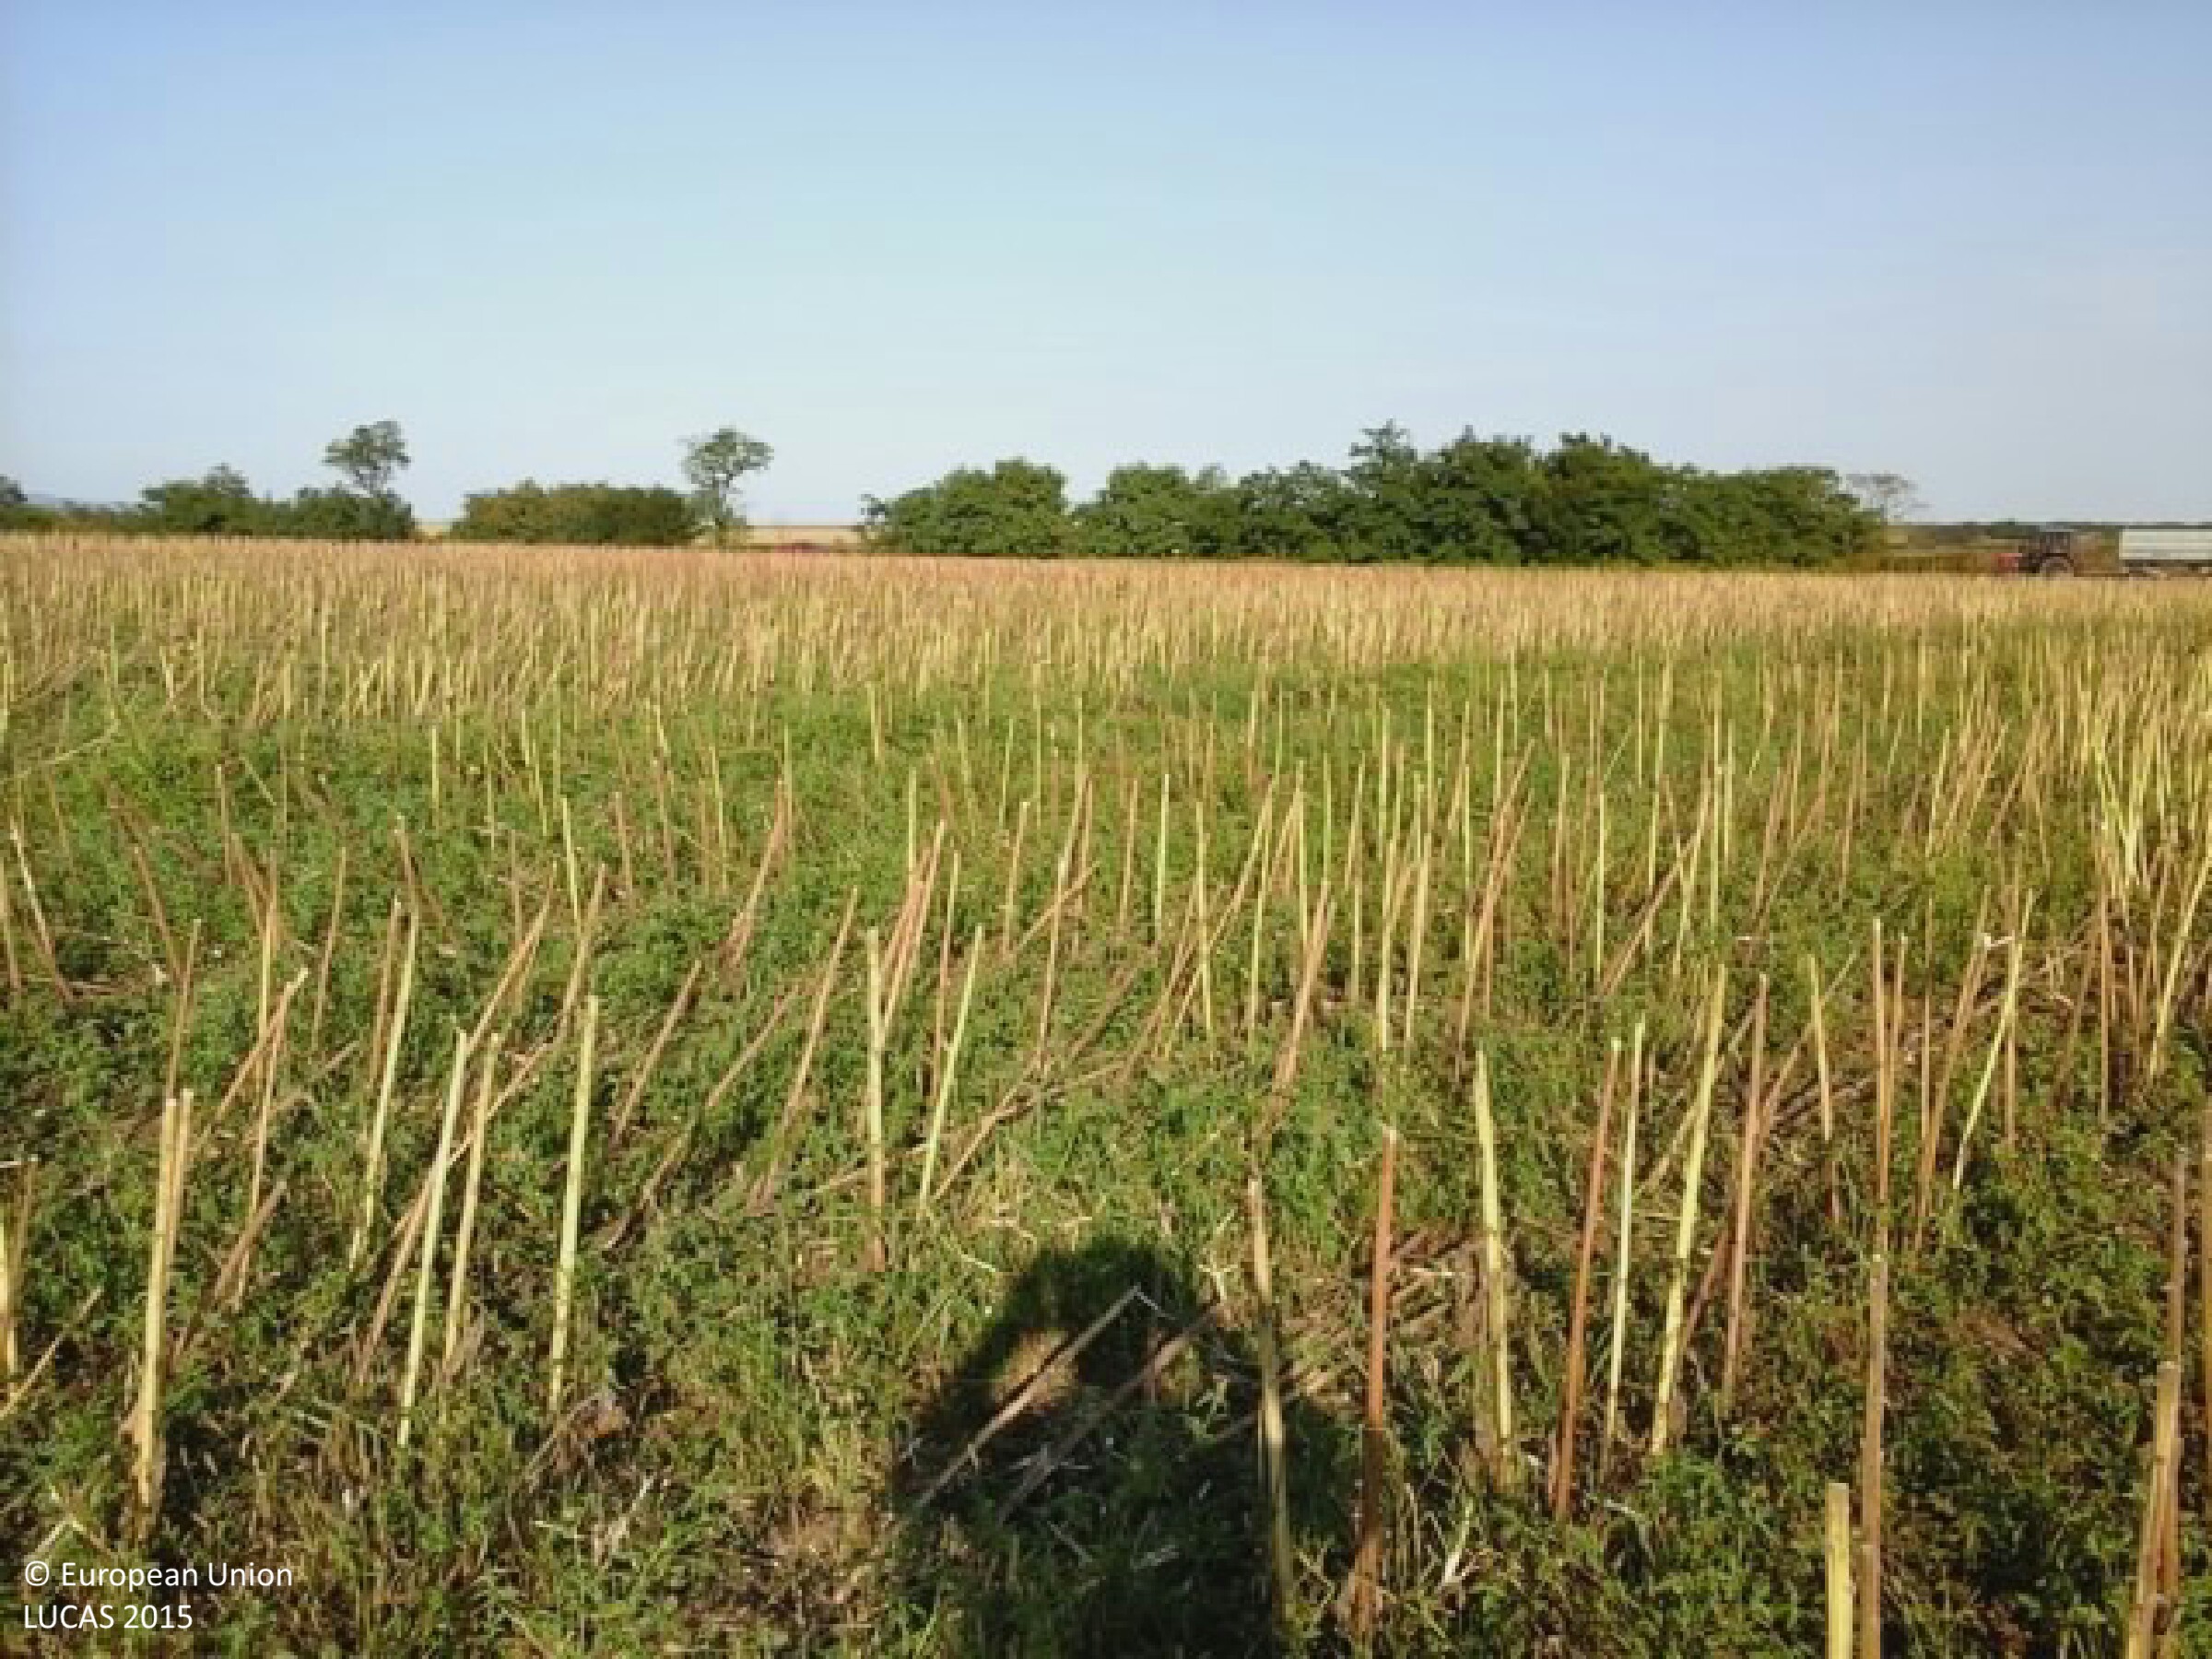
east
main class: Cropland
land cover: Sunflower
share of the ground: < 10 %
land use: Agriculture (excluding fallow land and kitchen gardens)
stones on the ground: < 10 %
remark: Harvested field
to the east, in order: Sunflower; Grass margins; Ditches and canals; Grass margins; Paved roads, cycling and walking lanes; Grass margins; Ditches and canals; Grass margins; Common wheat; Grass margins; Tracks; Other bare soil
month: September
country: HU
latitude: 47.6889
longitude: 19.8712
